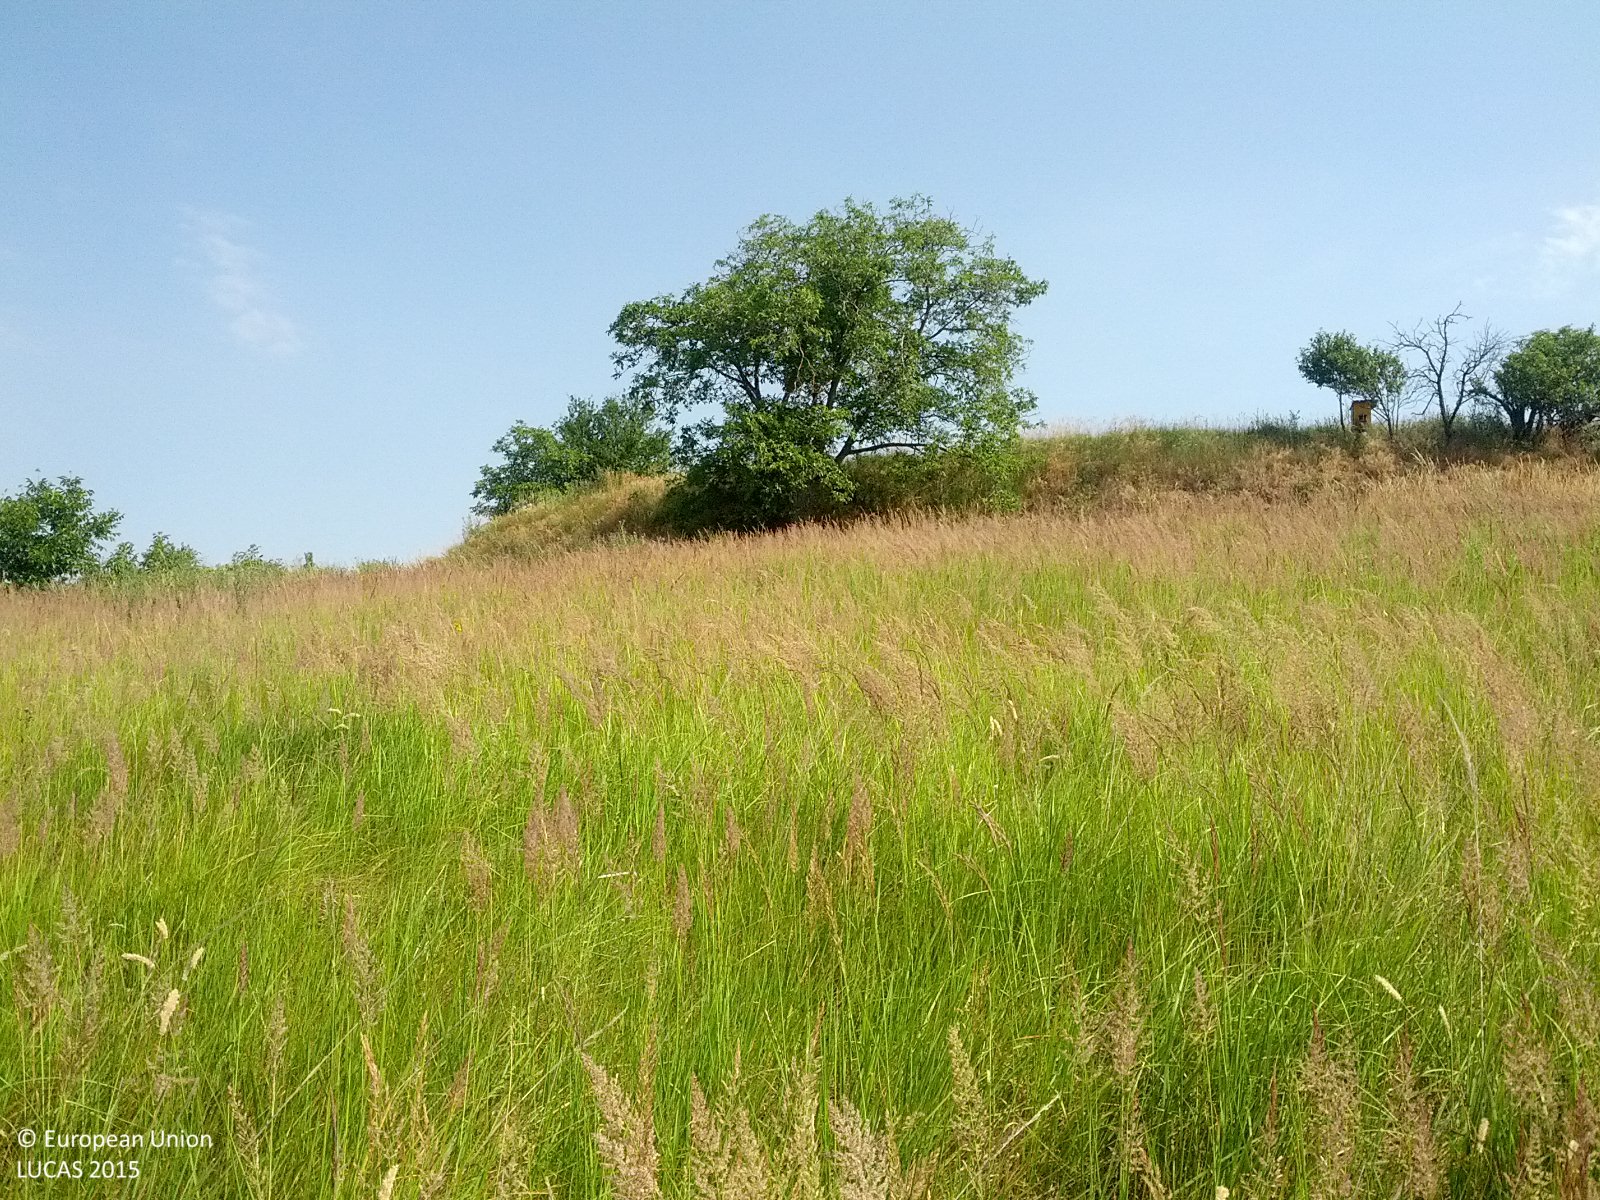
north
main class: Grassland
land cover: Grassland without tree/shrub cover
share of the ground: > 75 %
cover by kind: herbaceous plants 100 %
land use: Agriculture (excluding fallow land and kitchen gardens)
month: July
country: AT
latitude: 48.6695
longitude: 16.7016
